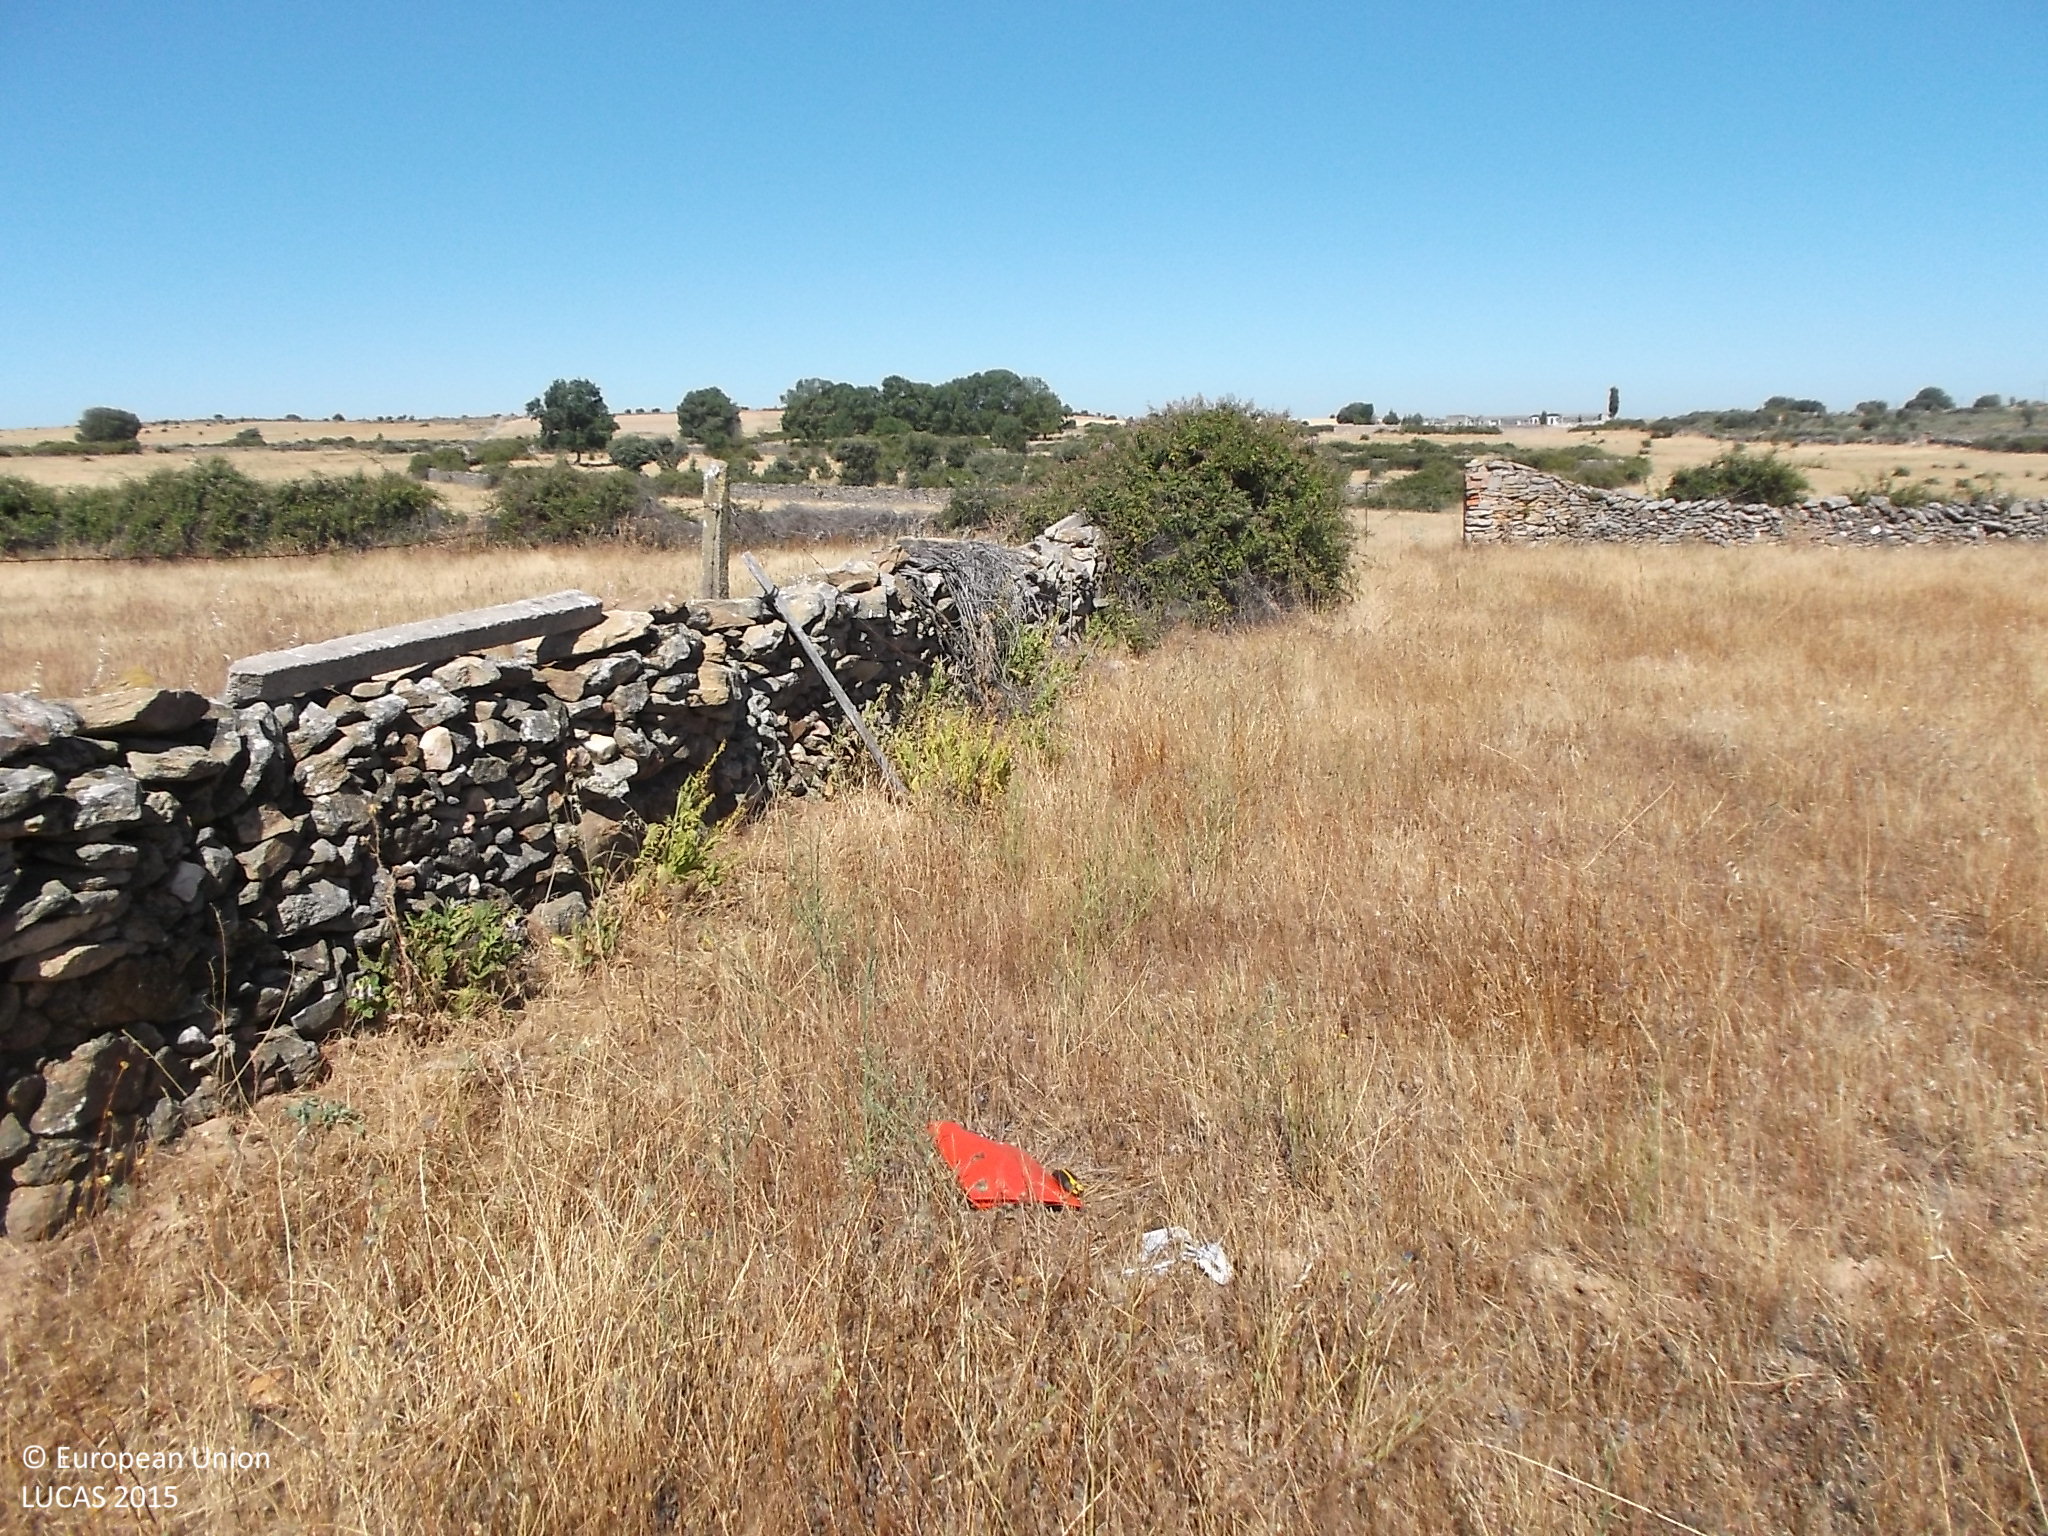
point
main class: Grassland
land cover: Grassland without tree/shrub cover
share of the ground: > 75 %
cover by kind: herbaceous plants 100 %
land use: Agriculture (excluding fallow land and kitchen gardens)
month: June
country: ES
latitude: 40.9108
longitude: -6.7811
